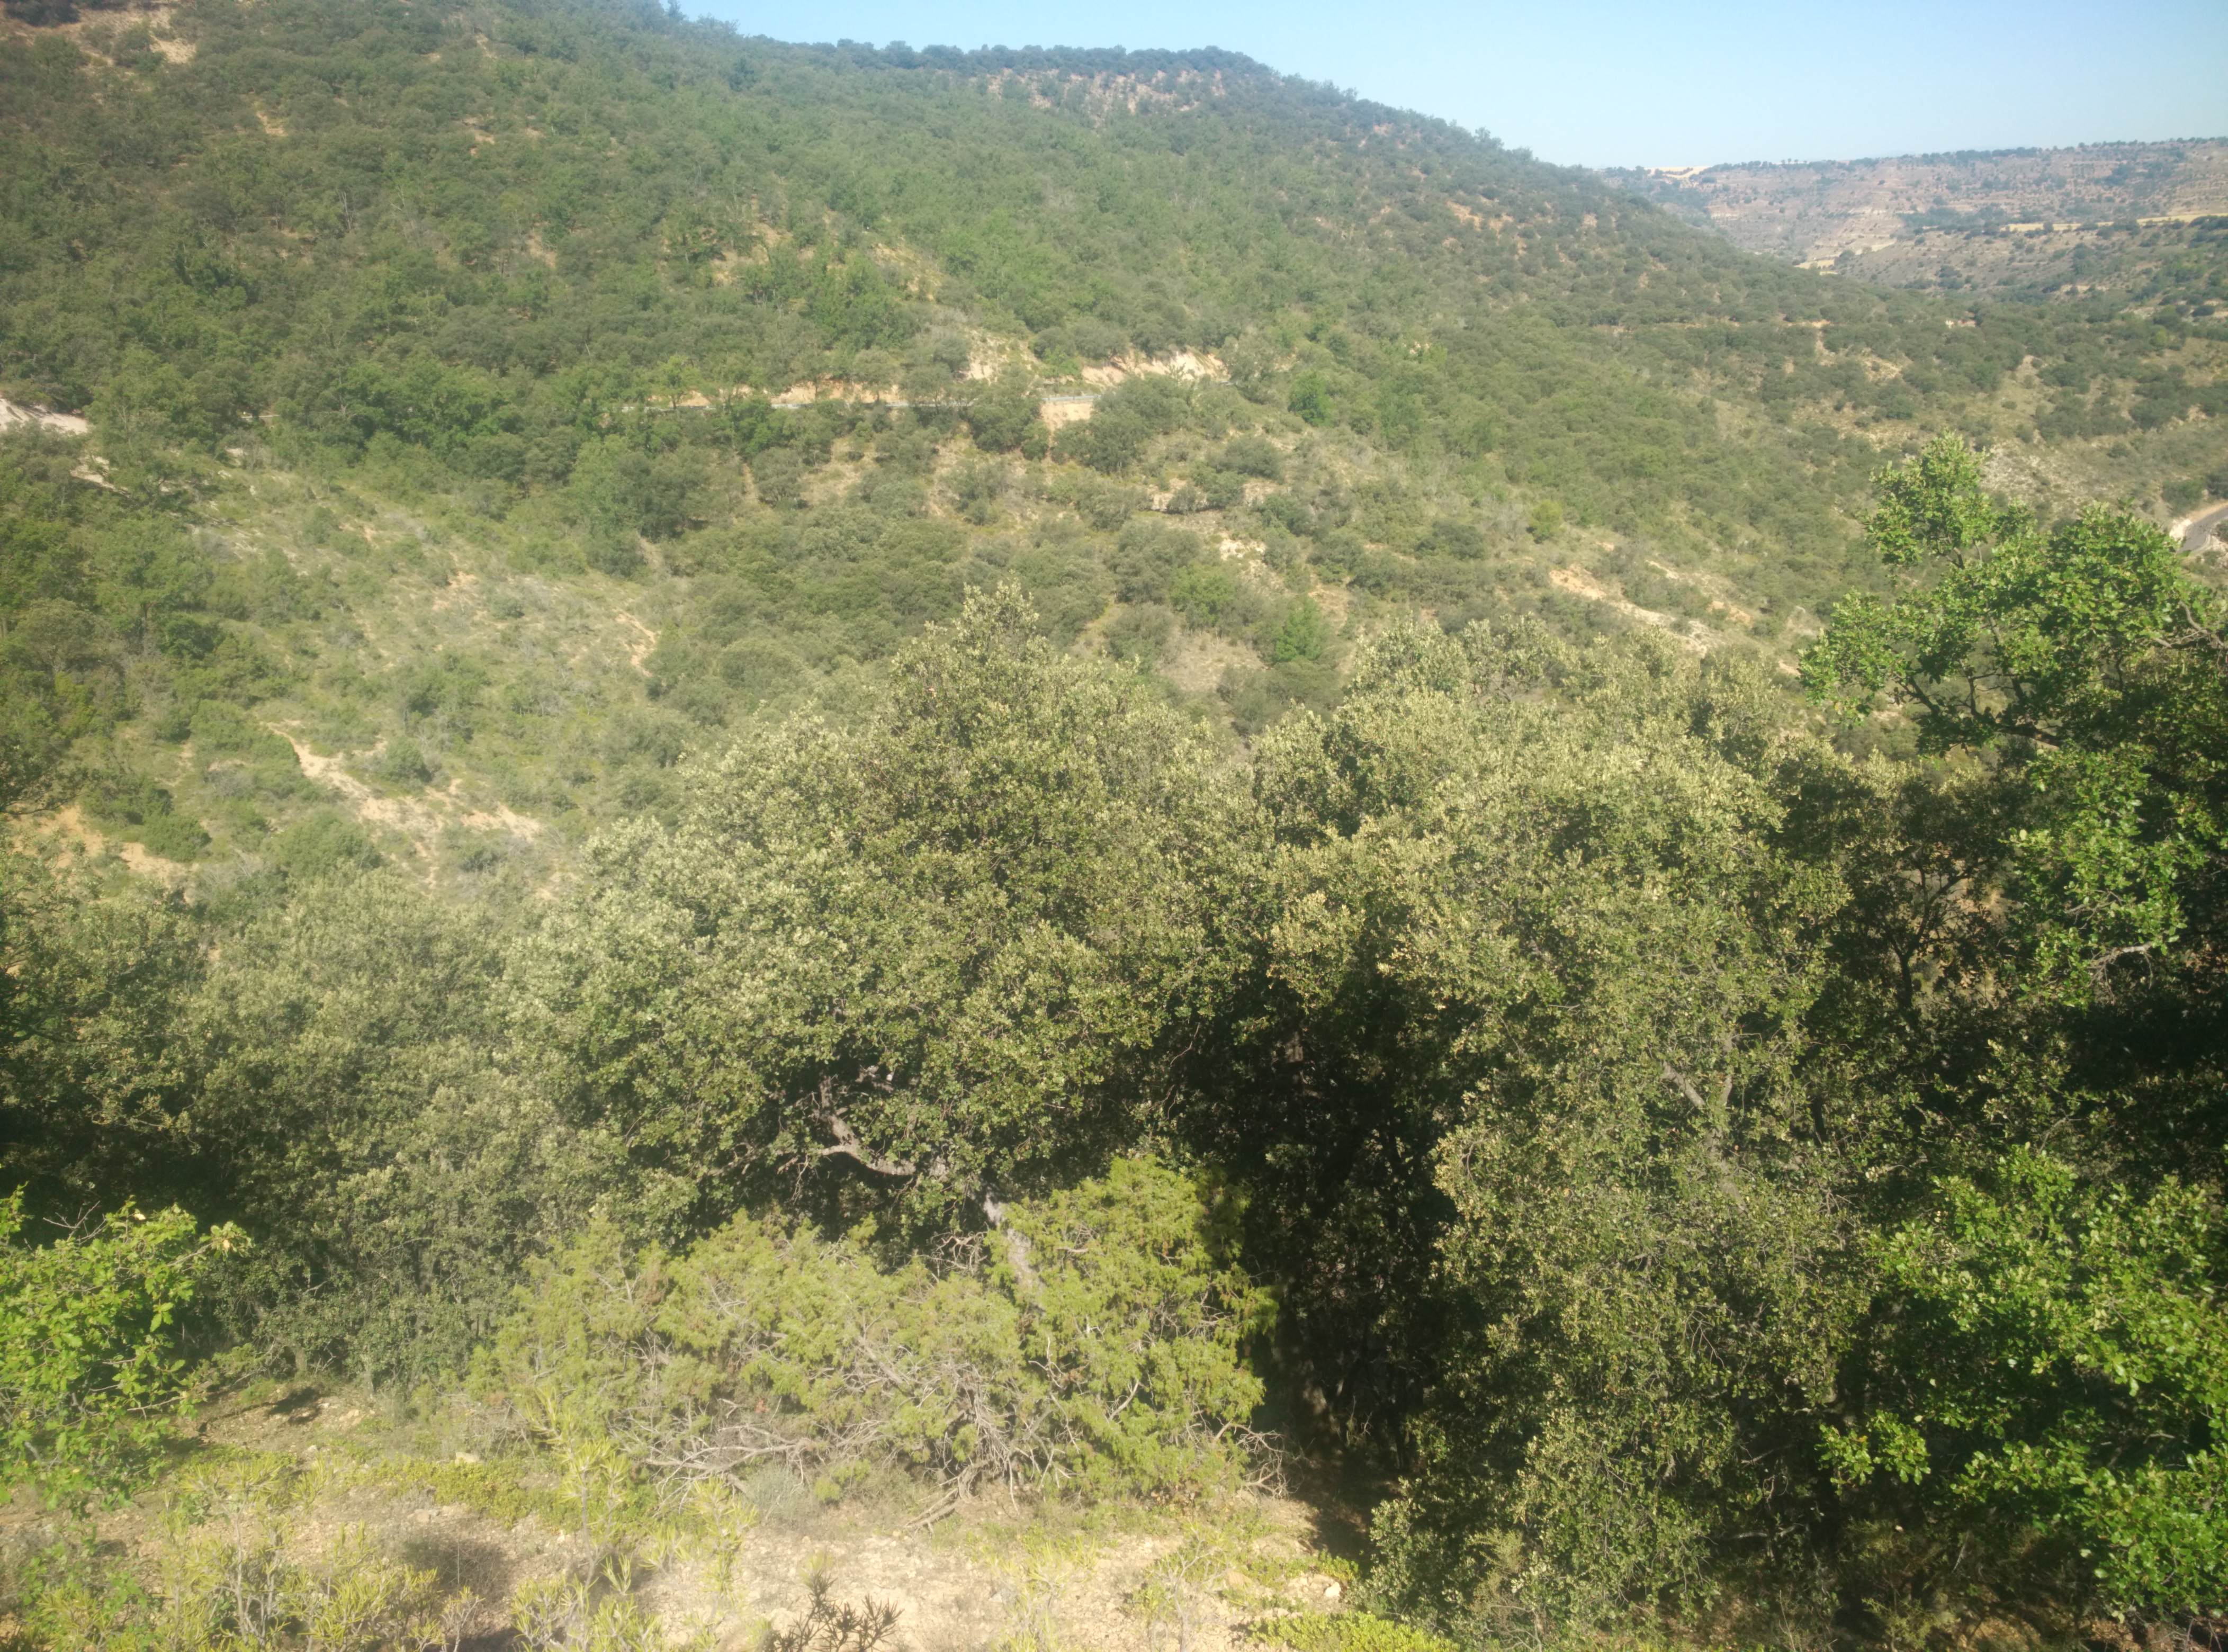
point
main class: Woodland
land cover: Broadleaved woodland
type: thermophilous deciduous forest
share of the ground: 50 - 75 %
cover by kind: broadleaved forest trees 60 %, unconsolidated bare surface 30 %, shrubs 10 %
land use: Semi-natural and natural areas not in use
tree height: > 5 m
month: July
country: ES
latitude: 40.7169
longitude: -2.8512
